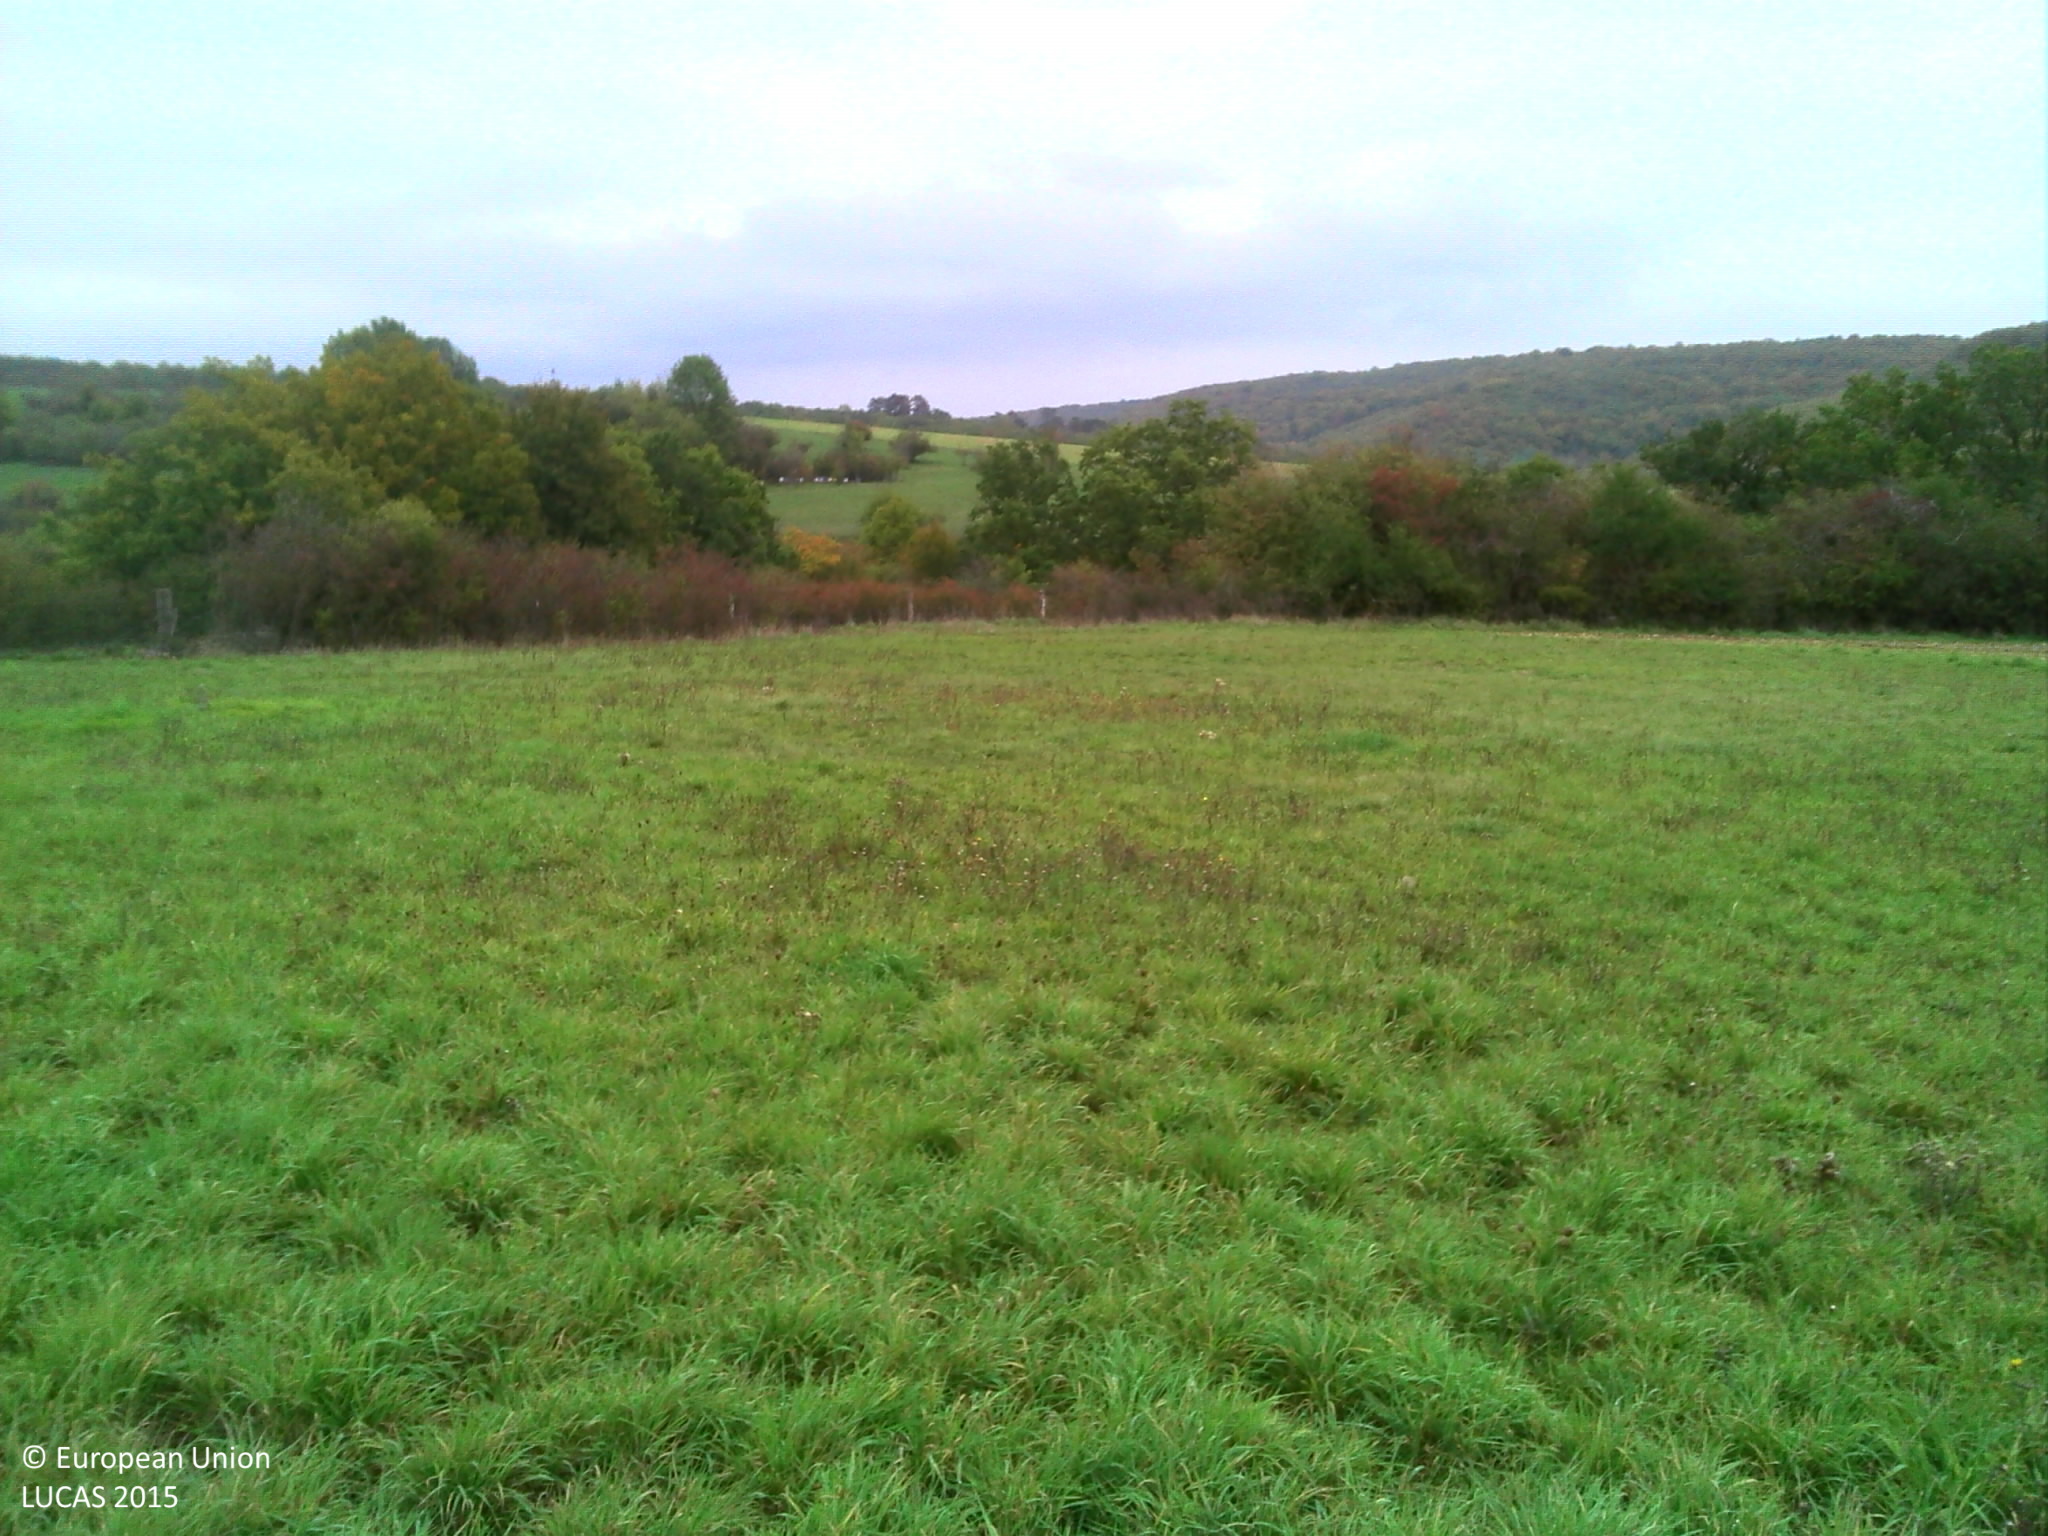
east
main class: Grassland
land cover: Grassland without tree/shrub cover
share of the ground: > 75 %
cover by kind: herbaceous plants 100 %
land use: Agriculture (excluding fallow land and kitchen gardens)
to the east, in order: Grassland without tree/shrub cover; Managed hedges; Fences; Grassland without tree/shrub cover; Spontaneously vegetated surfaces; Broadleaved woodland; Fences; Grassland without tree/shrub cover; Fences; Grass margins; Tracks; Grass margins; Temporary grasslands
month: October
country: FR
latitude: 47.4560
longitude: 4.8933
